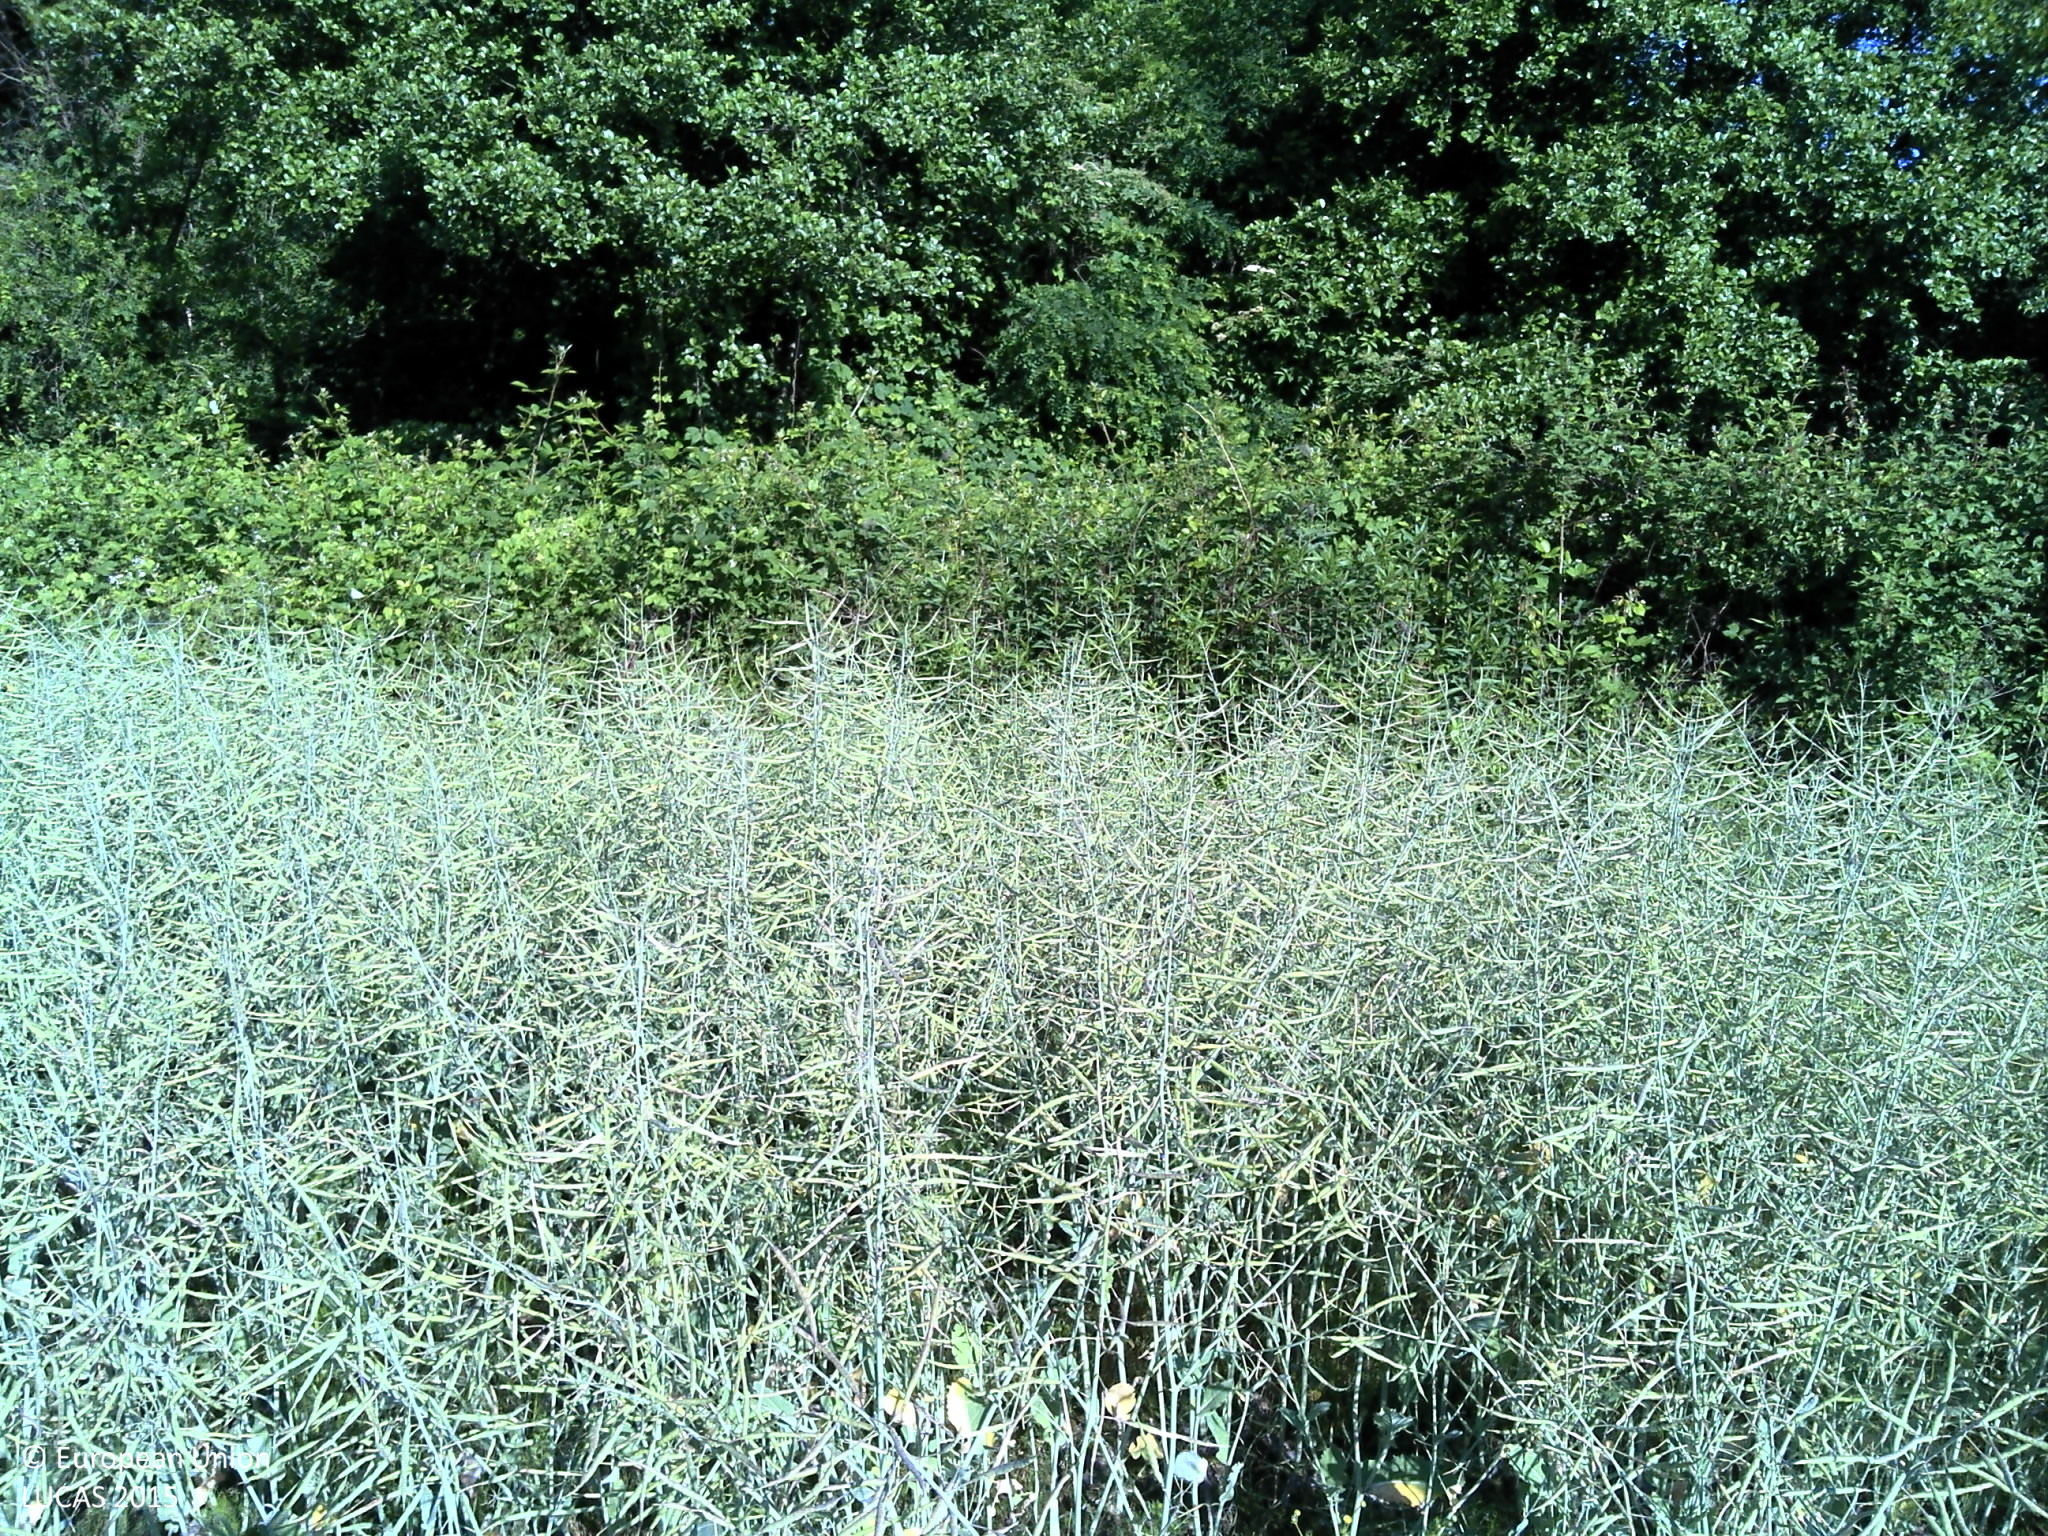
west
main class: Cropland
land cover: Rape and turnip rape
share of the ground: > 75 %
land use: Agriculture (excluding fallow land and kitchen gardens)
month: May
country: HR
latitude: 45.5694
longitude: 17.9094
